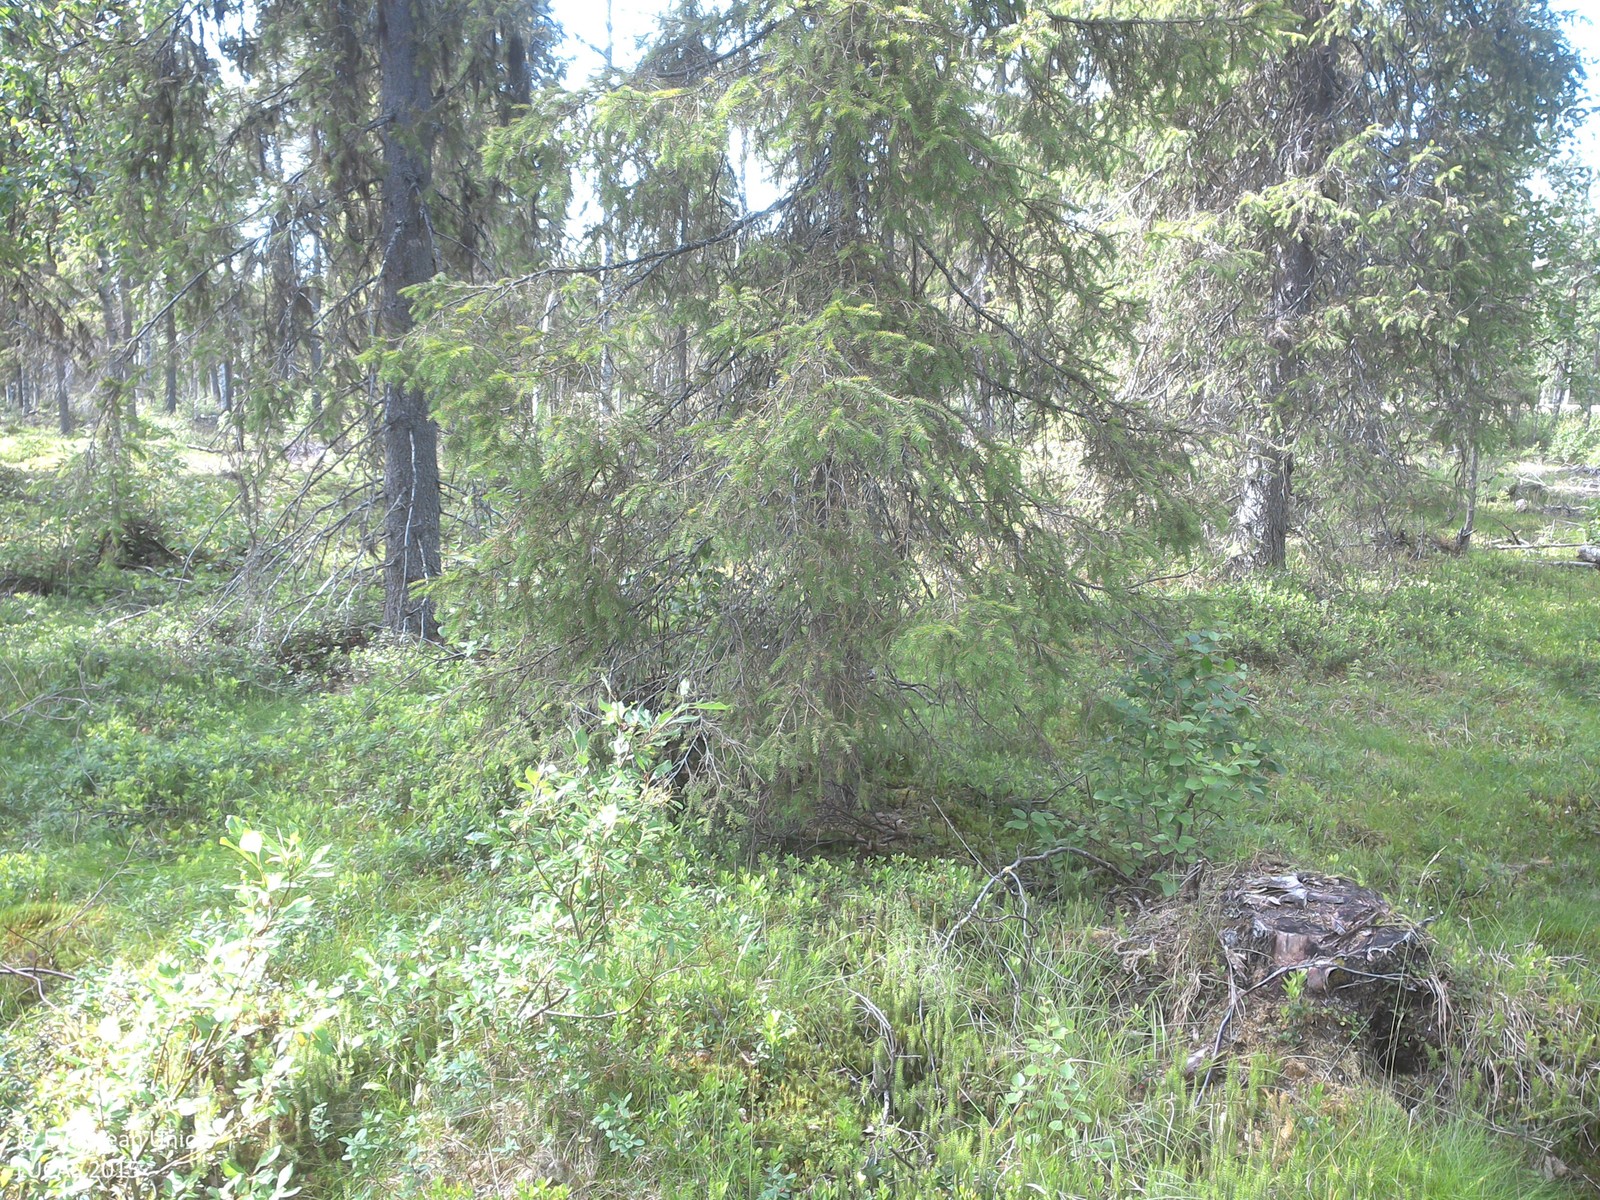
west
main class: Woodland
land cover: Spruce dominated mixed woodland
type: boreal forest
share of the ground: 25 - 50 %
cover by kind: shrubs 45 %, coniferous forest trees 25 %, broadleaved forest trees 10 %, herbaceous plants 10 %, lichens and mosses 10 %
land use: Forestry
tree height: > 5 m
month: July
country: SE
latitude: 67.5237
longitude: 23.4459
